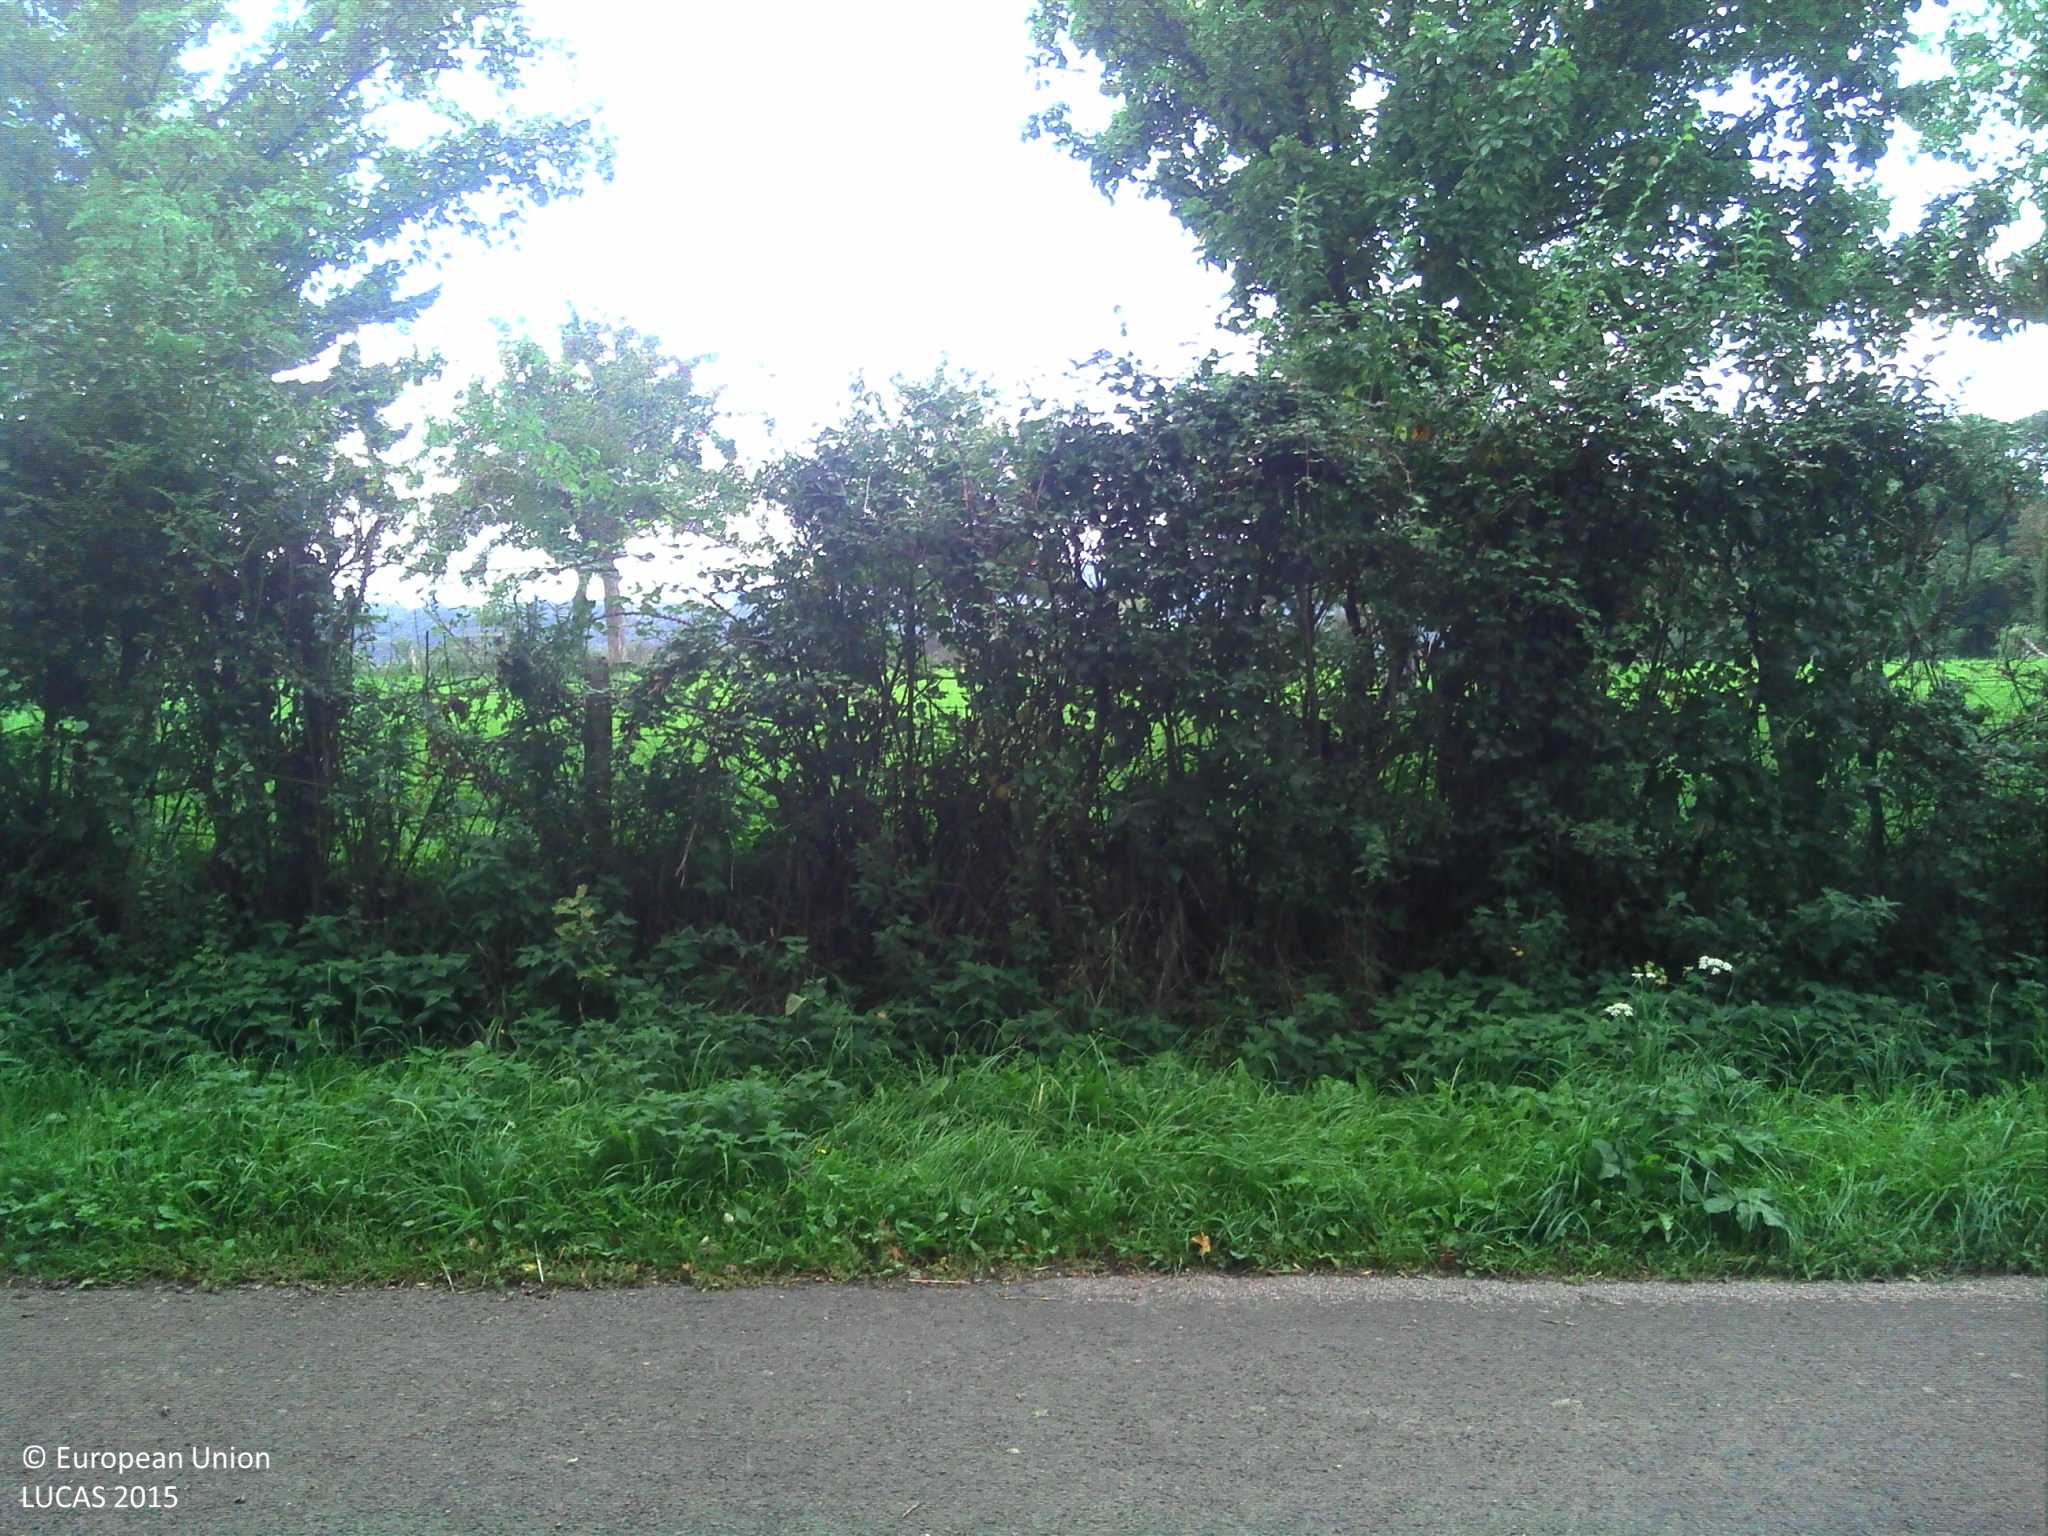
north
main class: Woodland
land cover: Broadleaved woodland
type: mesophytic deciduous forest
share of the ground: > 75 %
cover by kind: broadleaved forest trees 75 %, shrubs 15 %, herbaceous plants 10 %
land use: Forestry
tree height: > 5 m
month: September
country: FR
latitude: 48.7474
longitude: -0.1914
